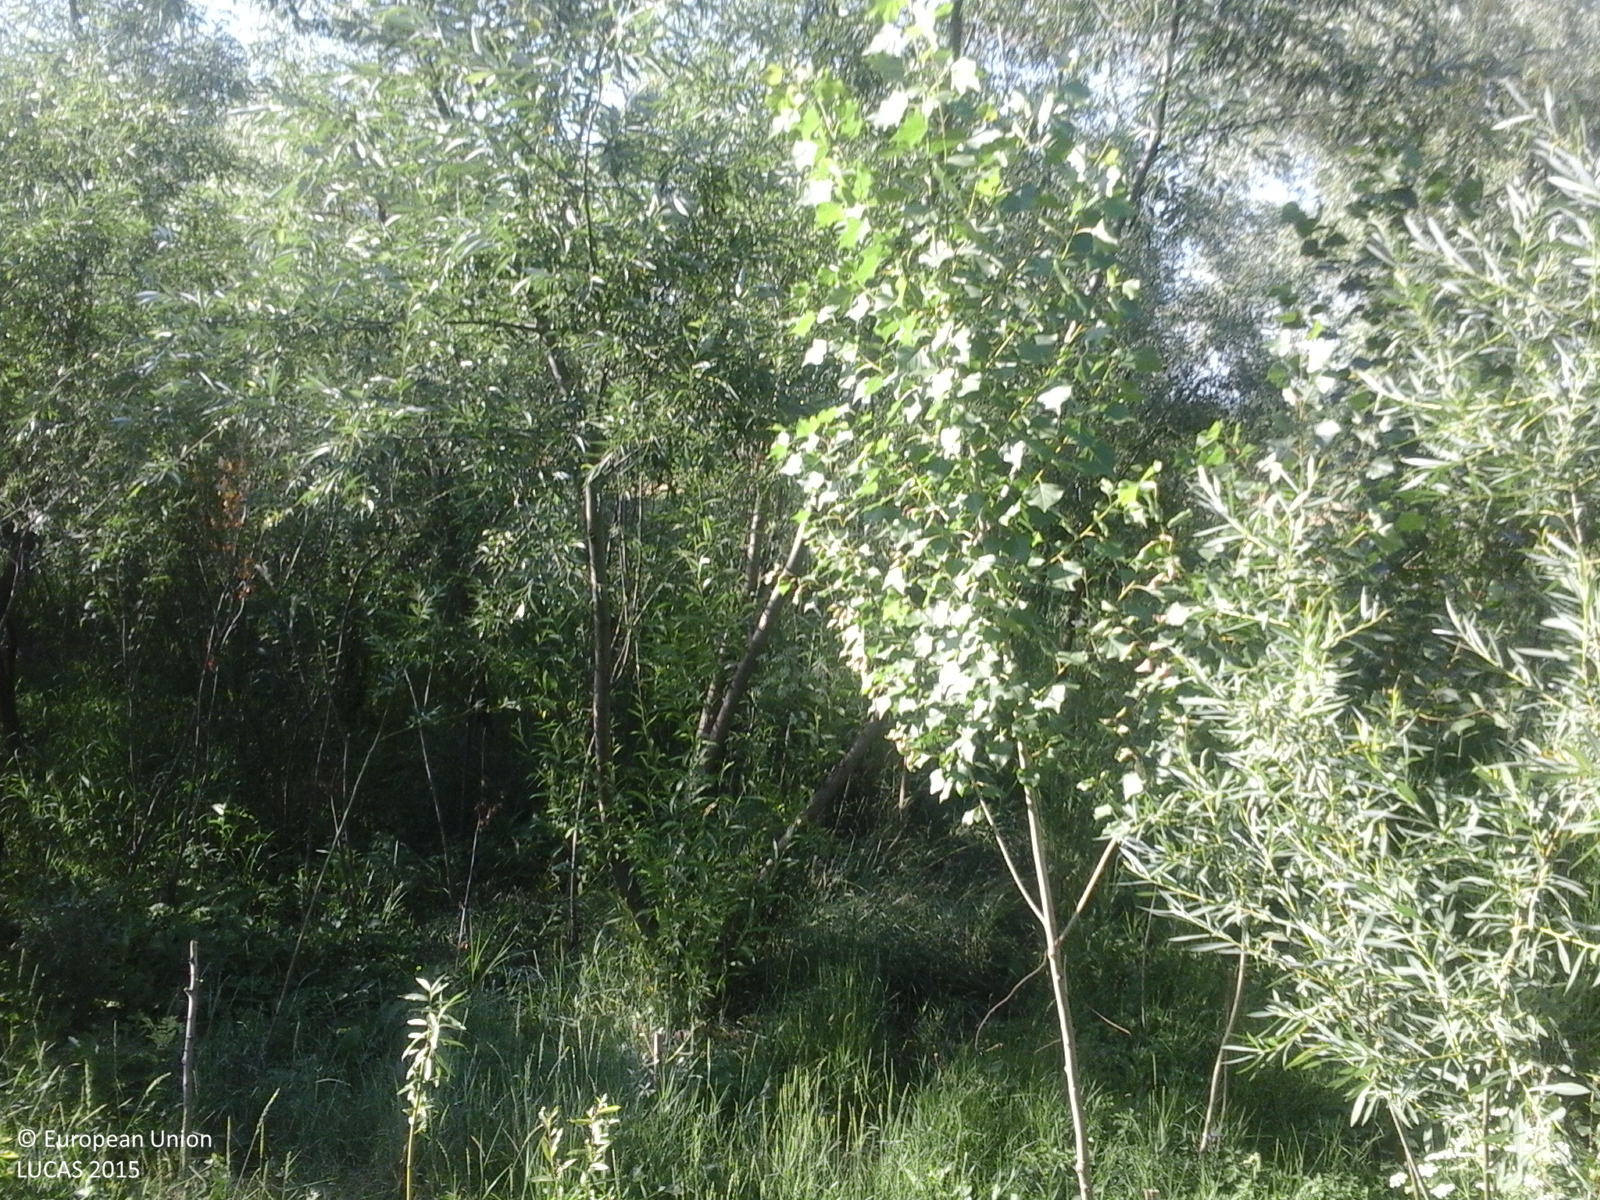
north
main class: Woodland
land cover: Broadleaved woodland
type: broadleaved evergreen forest
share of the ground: > 75 %
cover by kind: broadleaved forest trees 100 %
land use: Forestry
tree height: > 5 m
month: June
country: RO
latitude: 47.7551
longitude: 27.2266
